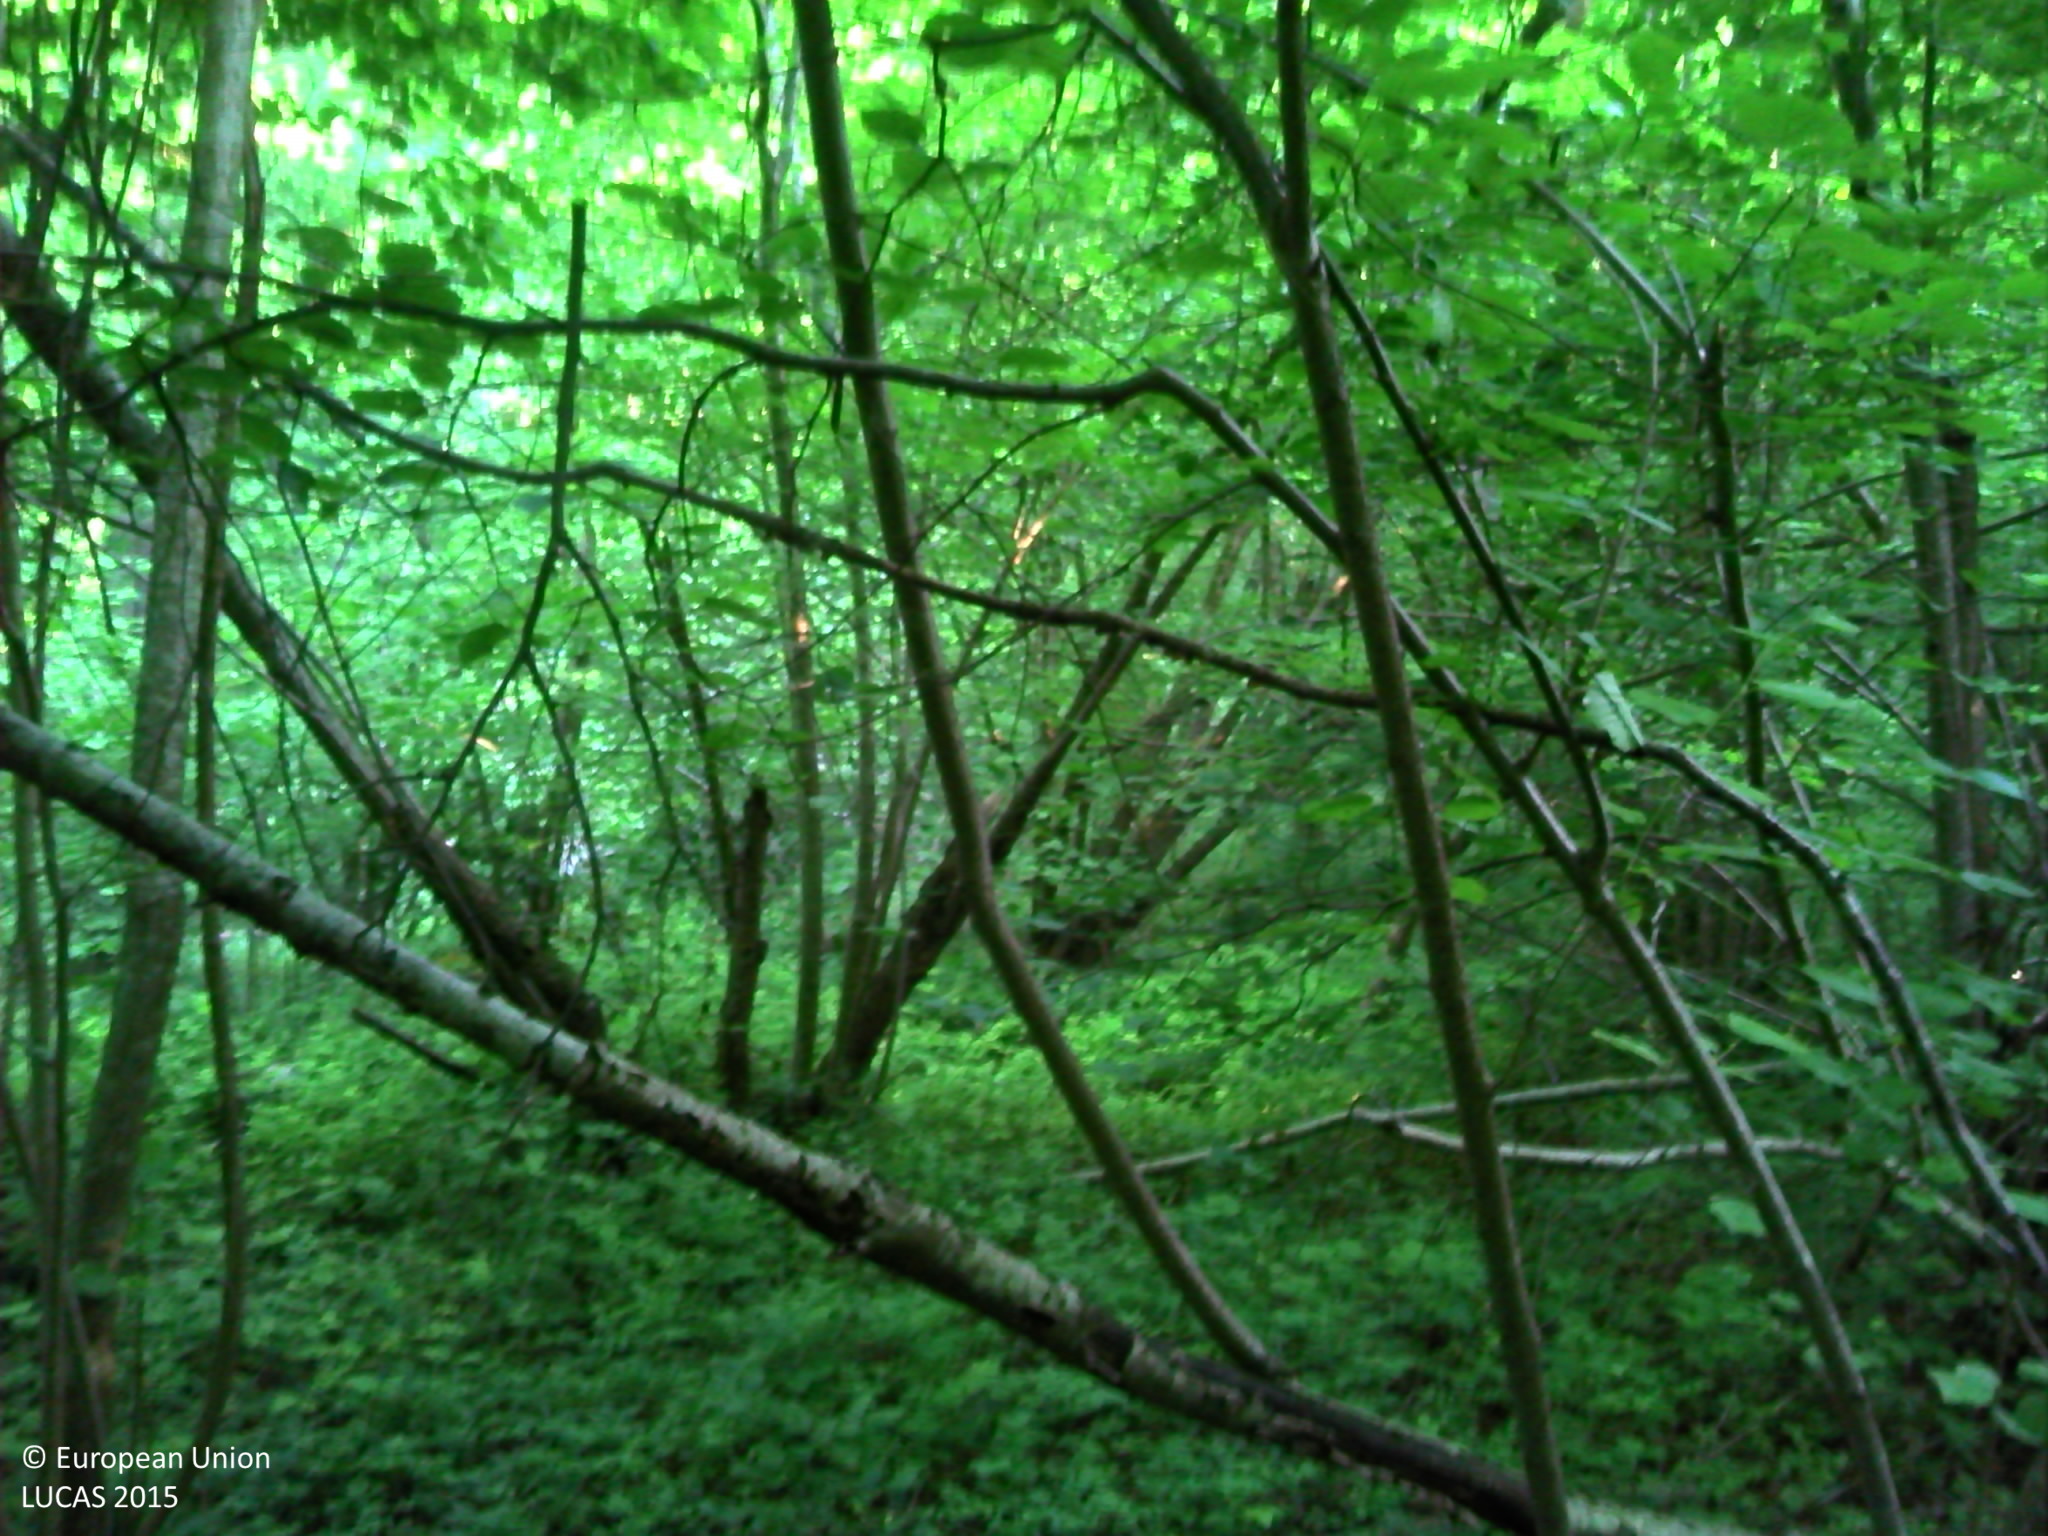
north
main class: Woodland
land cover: Broadleaved woodland
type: mesophytic deciduous forest
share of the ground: > 75 %
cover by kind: broadleaved forest trees 85 %, shrubs 10 %, herbaceous plants 5 %
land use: Forestry
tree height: > 5 m
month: June
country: FR
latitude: 49.5423
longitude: 2.8171
